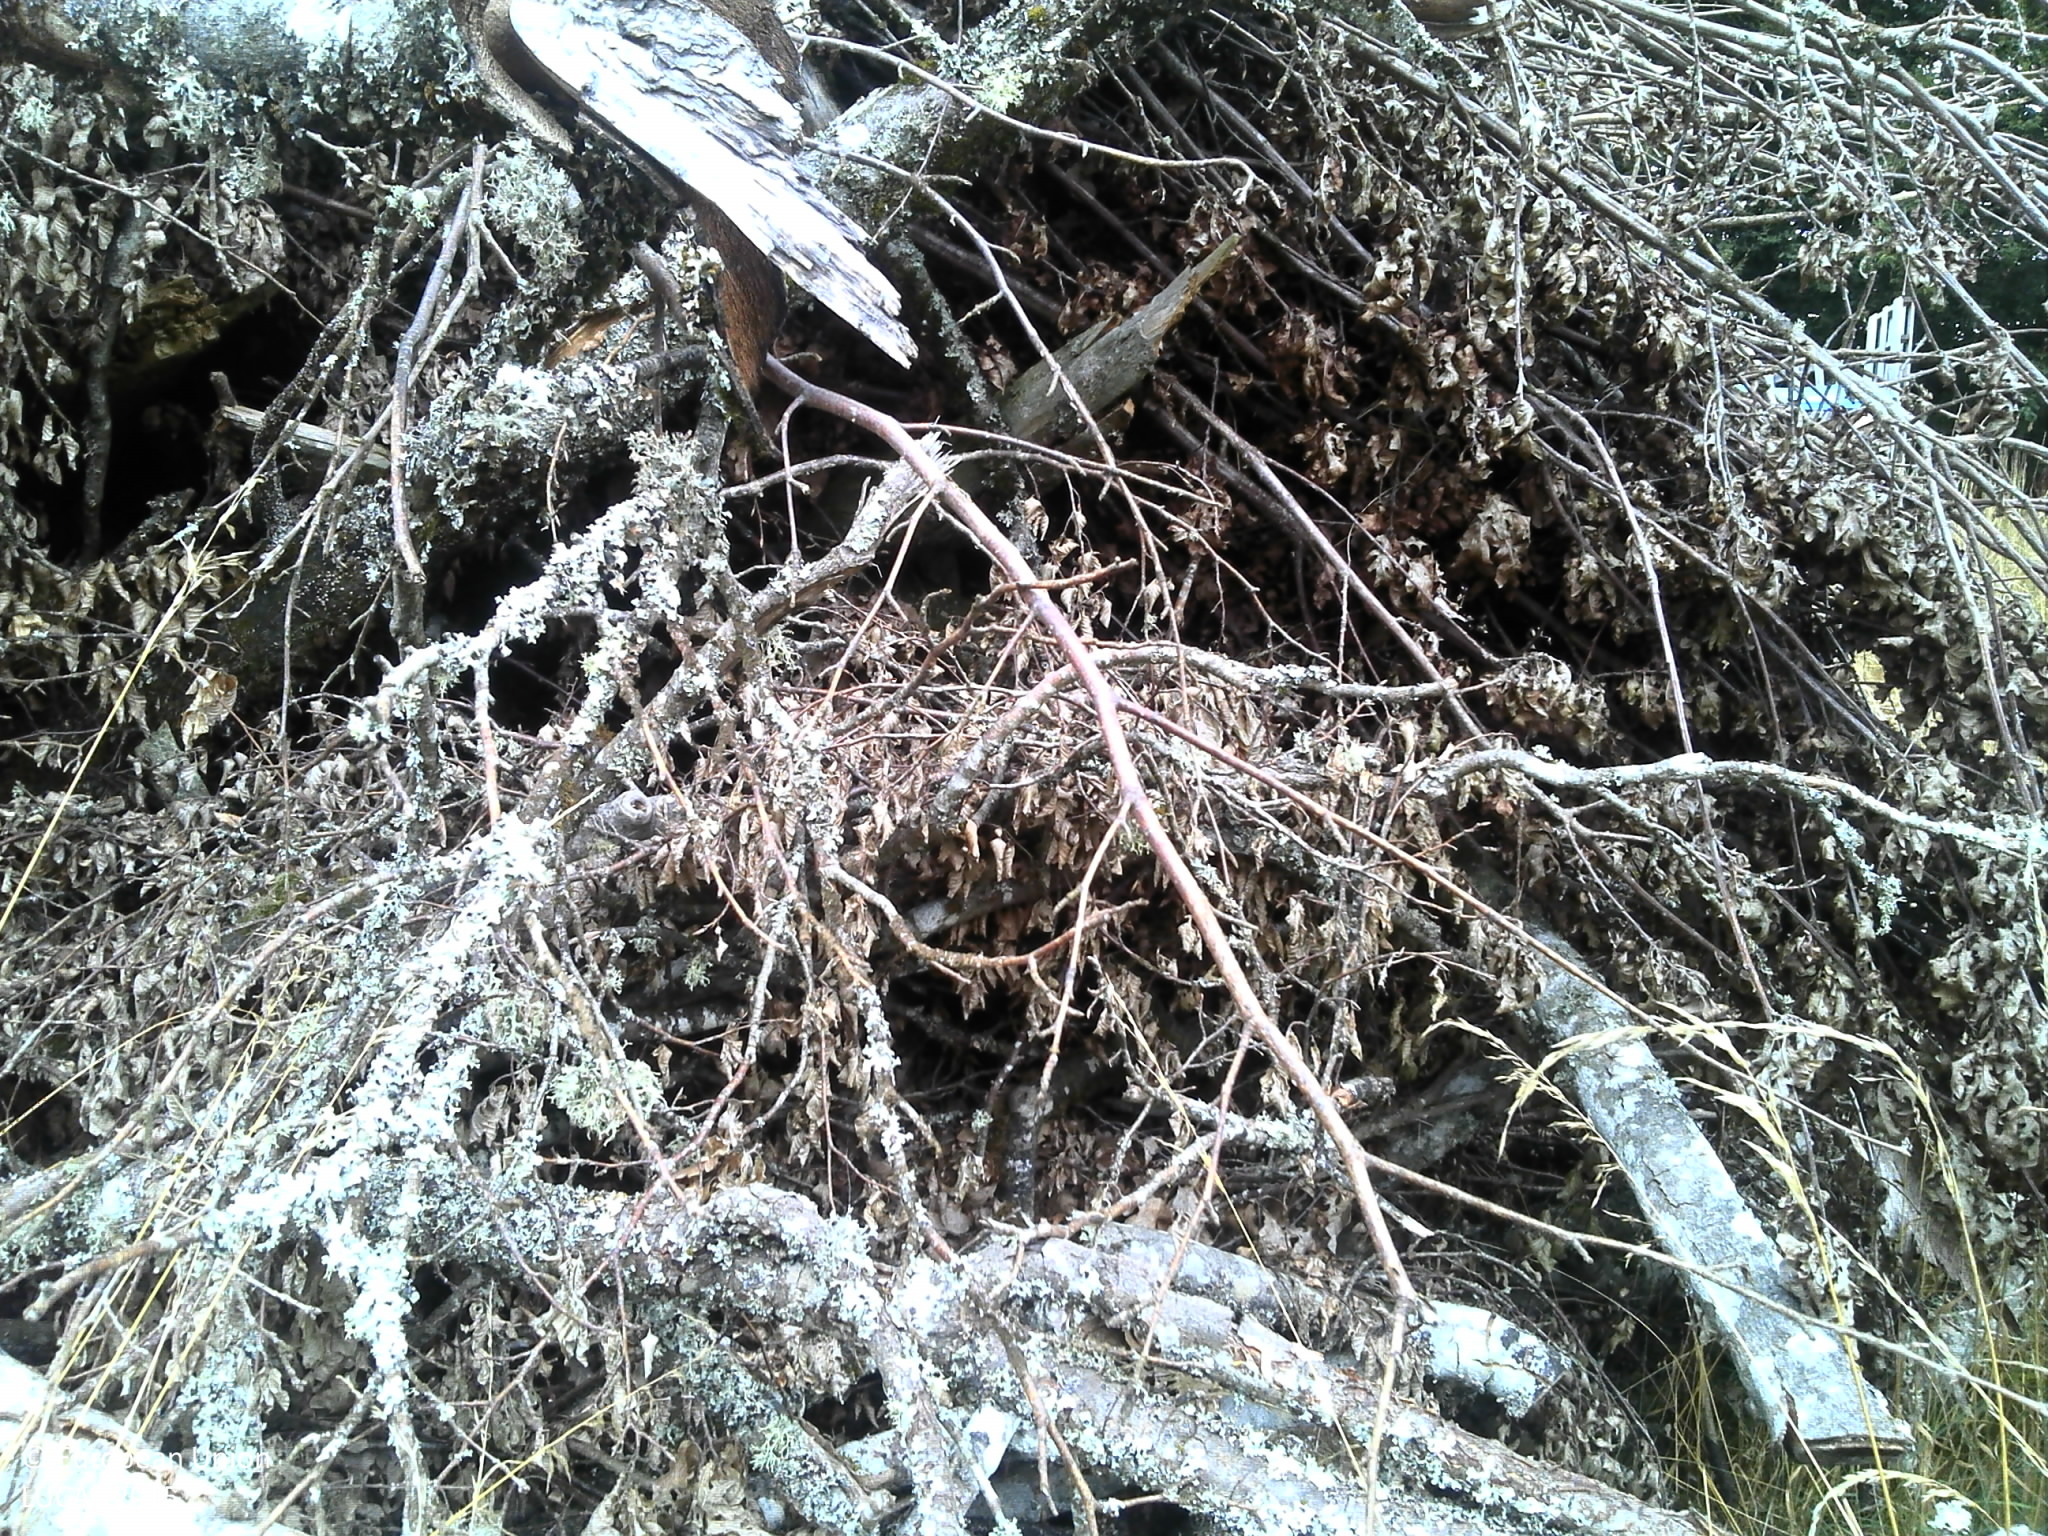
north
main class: Grassland
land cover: Grassland with sparse tree/shrub cover
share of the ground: > 75 %
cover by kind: herbaceous plants 95 %, broadleaved forest trees 5 %
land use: Agriculture (excluding fallow land and kitchen gardens)
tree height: > 5 m
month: August
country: FR
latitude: 45.5487
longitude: 2.2994
